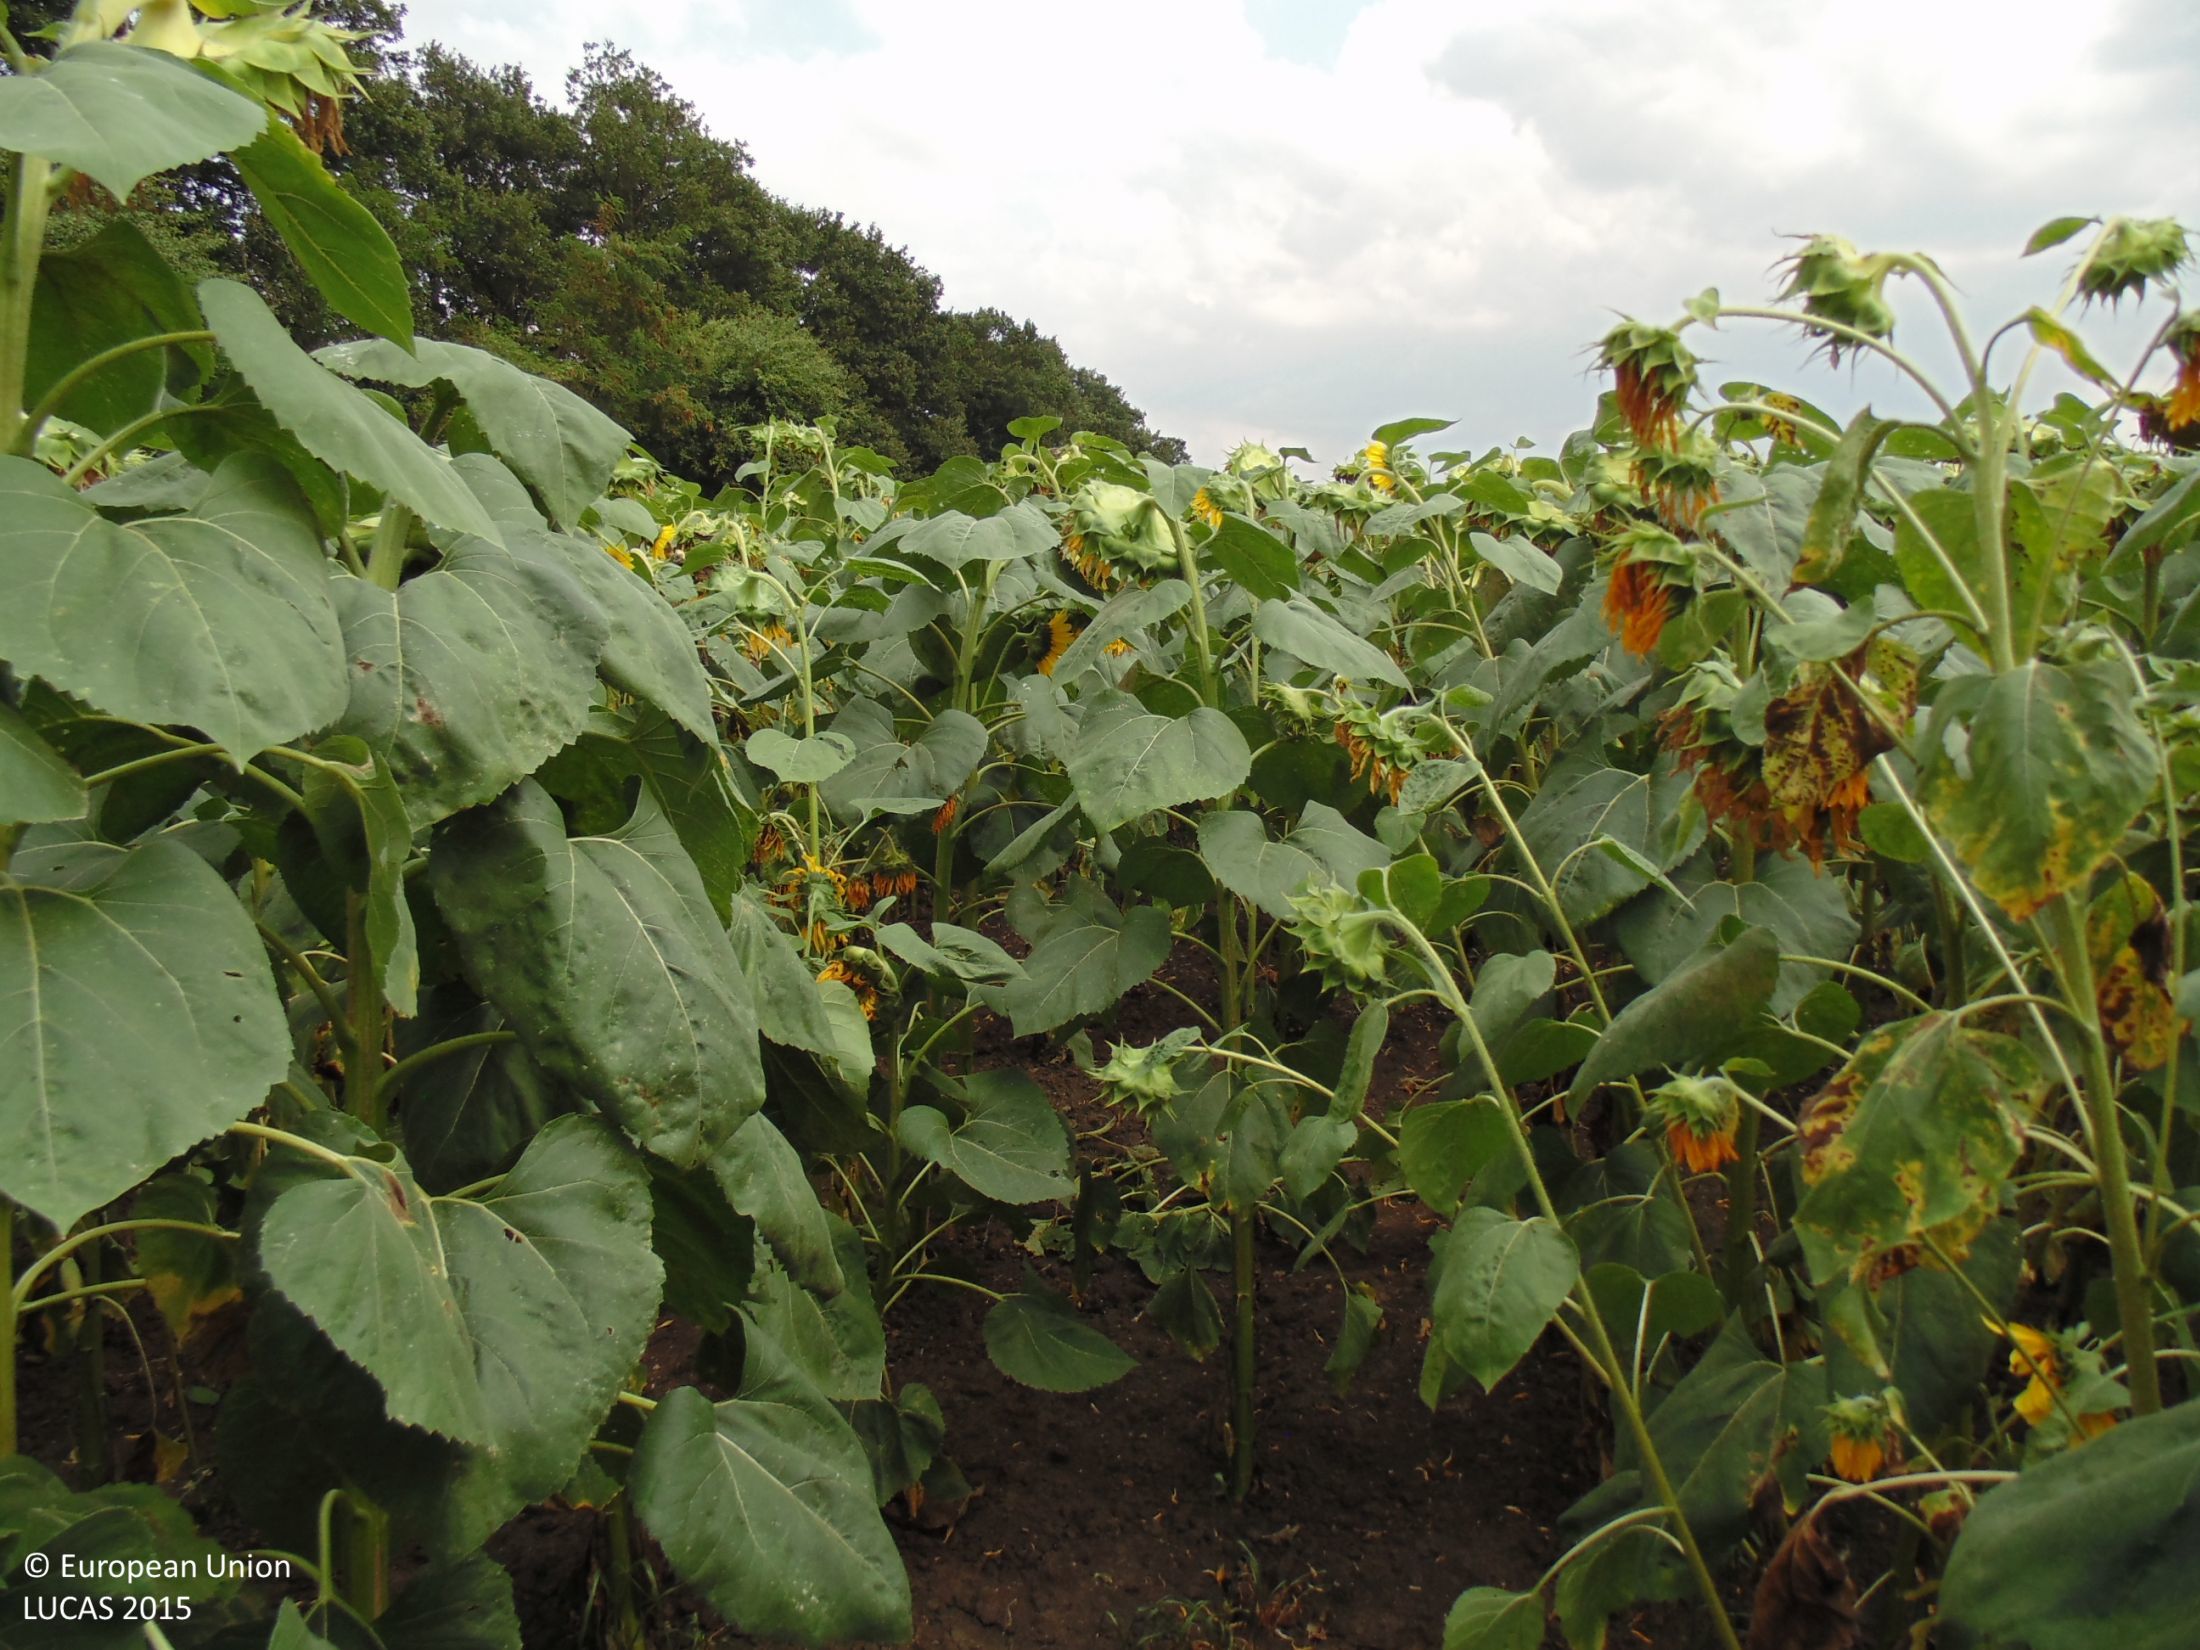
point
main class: Cropland
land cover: Sunflower
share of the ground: > 75 %
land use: Agriculture (excluding fallow land and kitchen gardens)
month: July
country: BG
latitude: 43.6046
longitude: 28.0248
